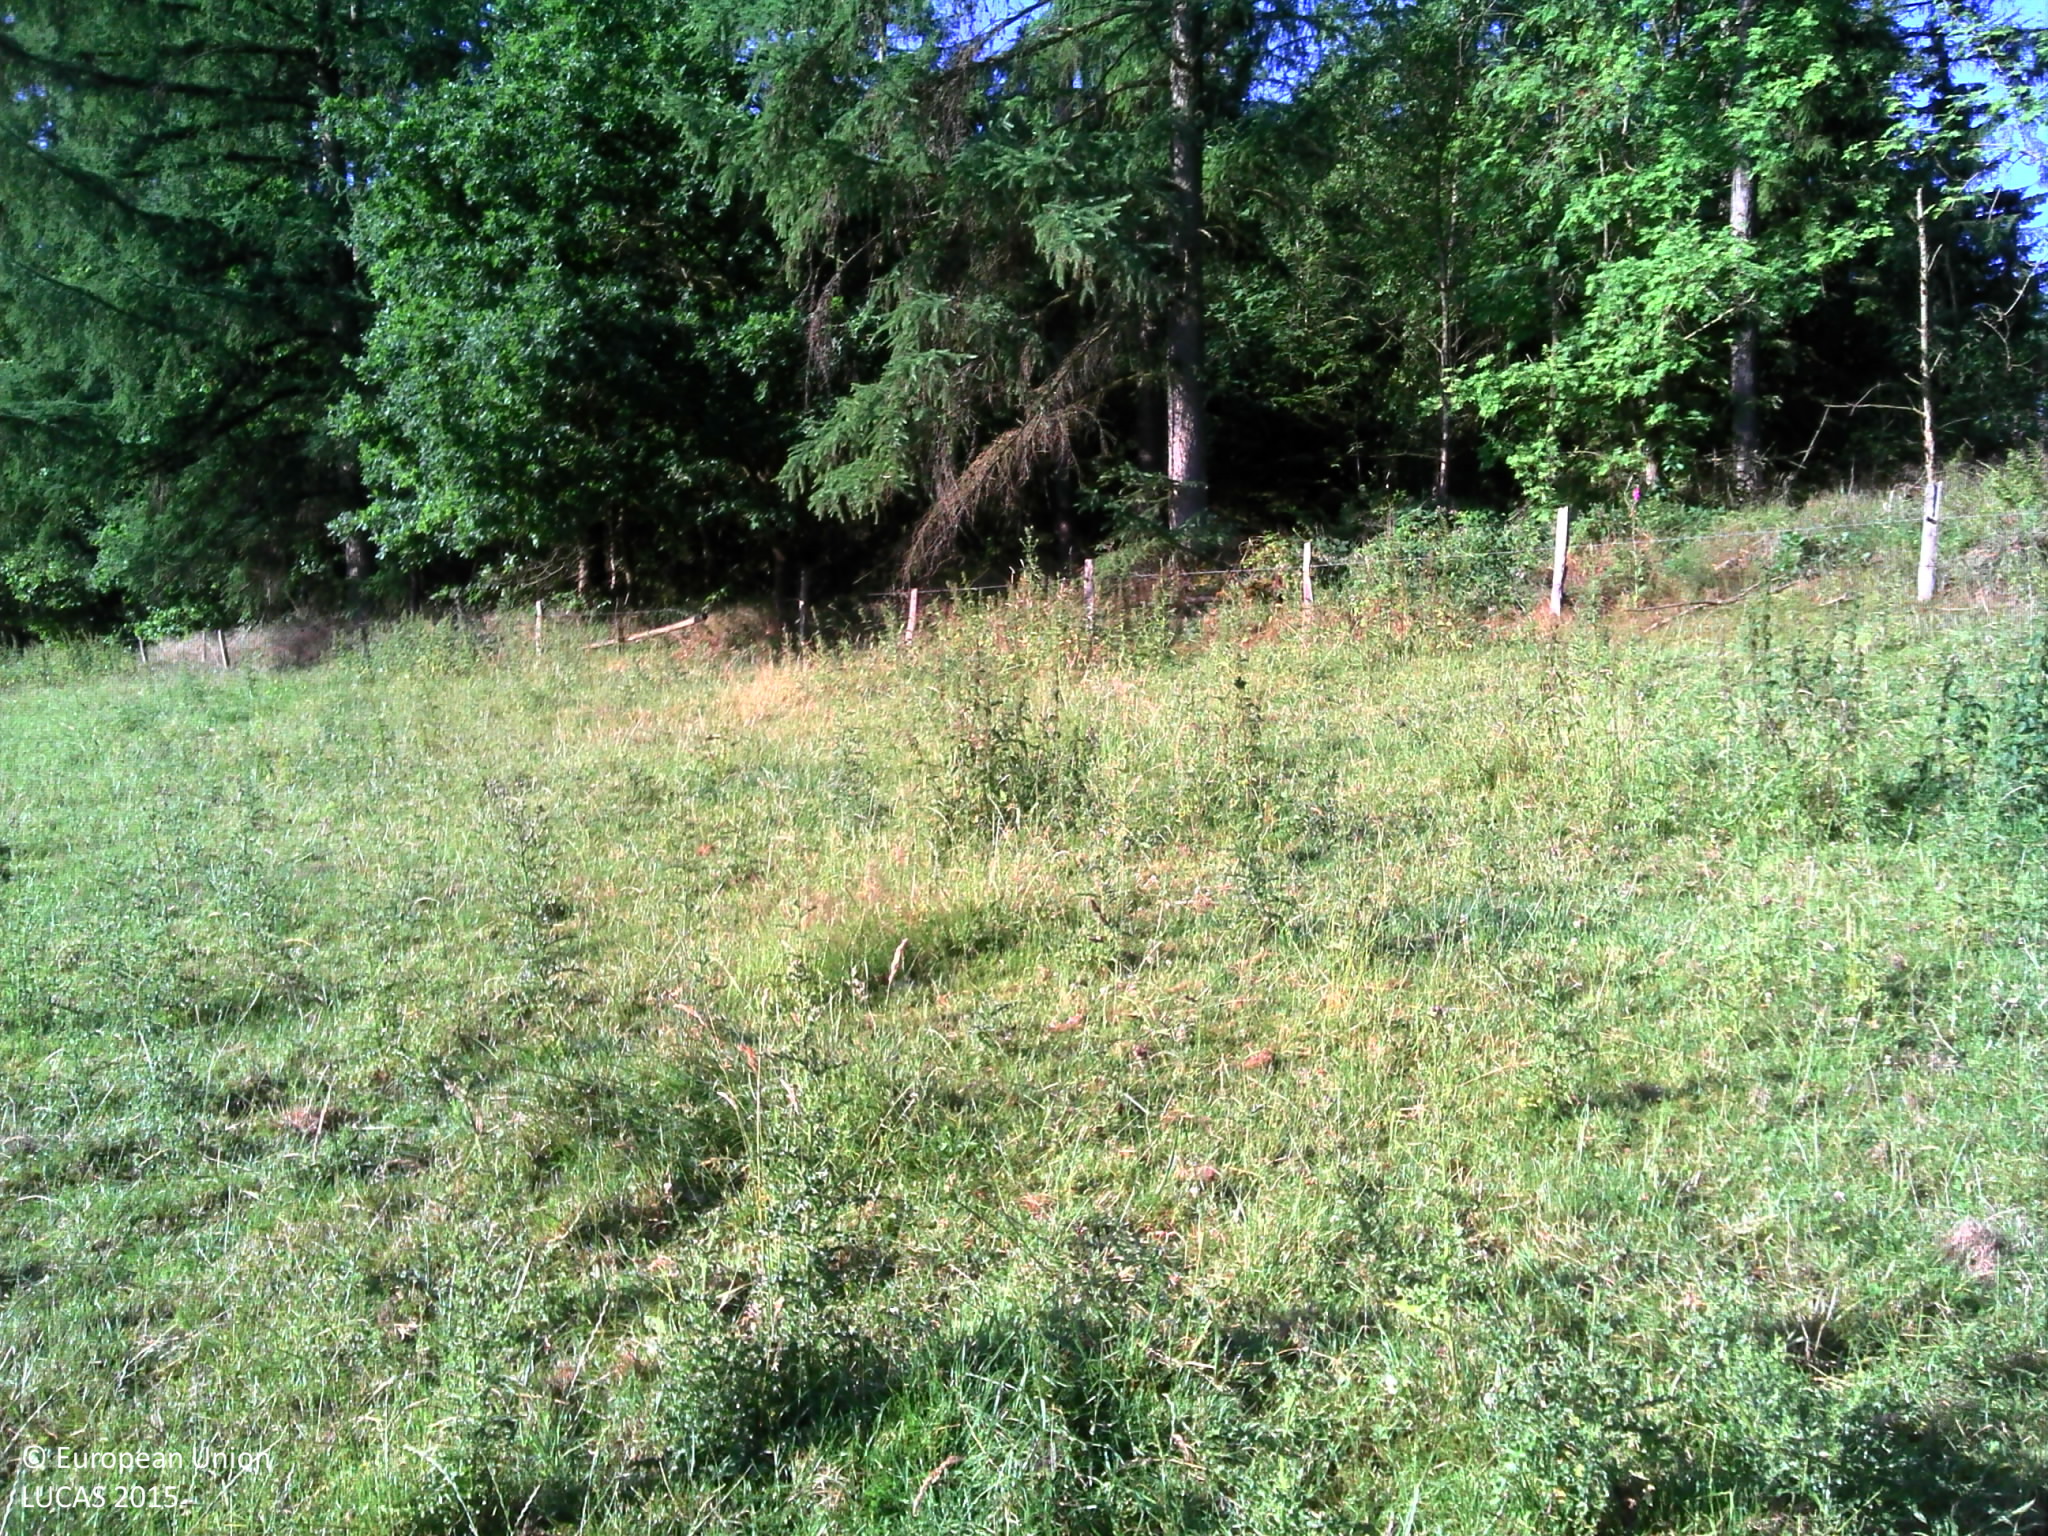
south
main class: Grassland
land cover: Grassland without tree/shrub cover
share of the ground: > 75 %
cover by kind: herbaceous plants 100 %
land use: Agriculture (excluding fallow land and kitchen gardens)
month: July
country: BE
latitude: 50.1182
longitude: 5.6210
